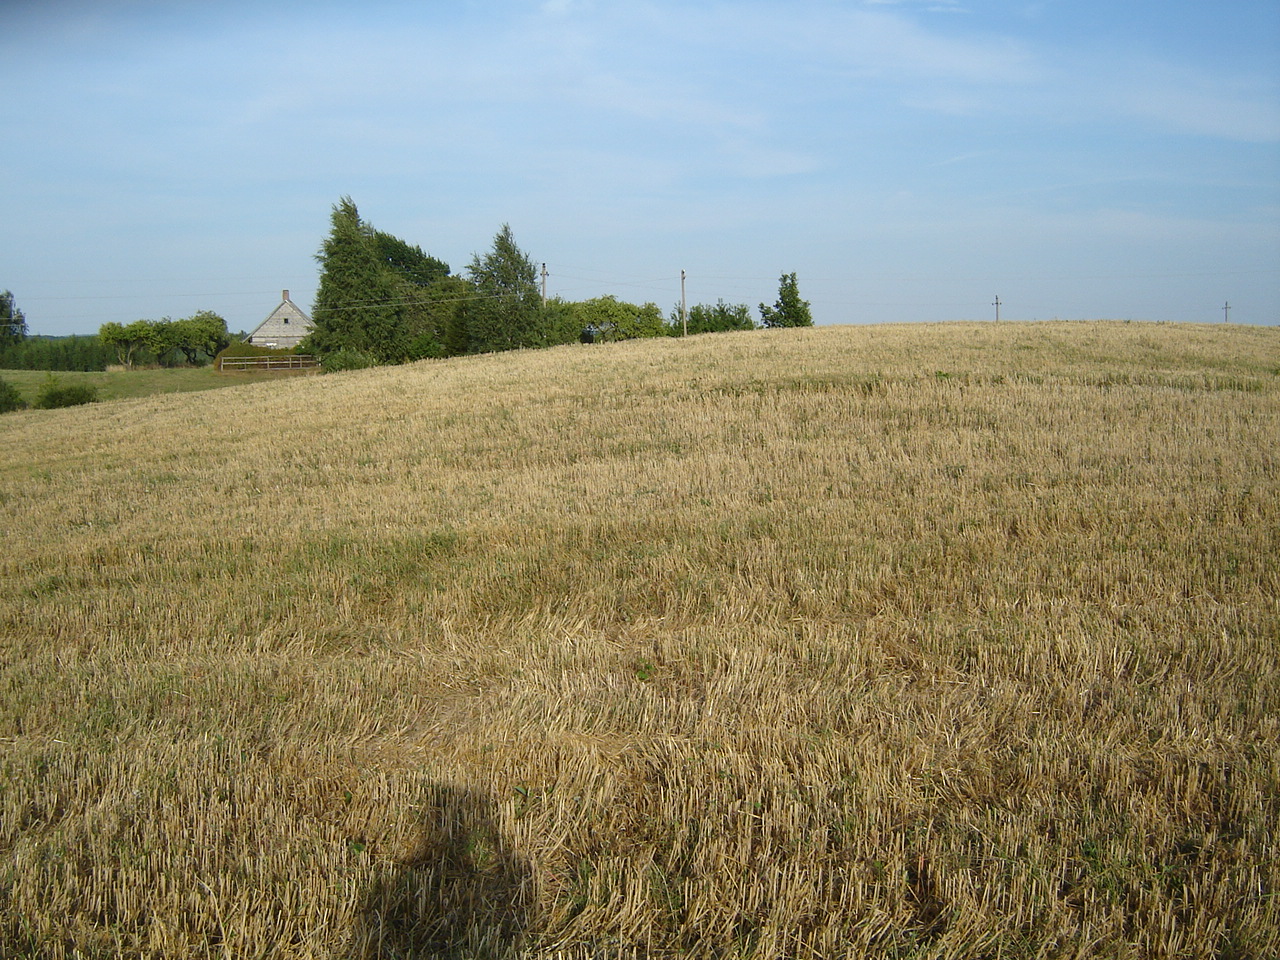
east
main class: Cropland
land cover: Barley
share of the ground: > 75 %
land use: Agriculture (excluding fallow land and kitchen gardens)
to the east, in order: Barley; Electric lines; Barley; Tracks; Grassland without tree/shrub cover; Tracks; Grassland without tree/shrub cover; Electric lines; Grassland without tree/shrub cover; Apple fruit; Grass margins; Broadleaved woodland; Potatoes; Single bushes/trees; Grassland without tree/shrub cover; Spontaneously vegetated surfaces
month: August
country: LT
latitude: 54.7134
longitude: 24.8412
